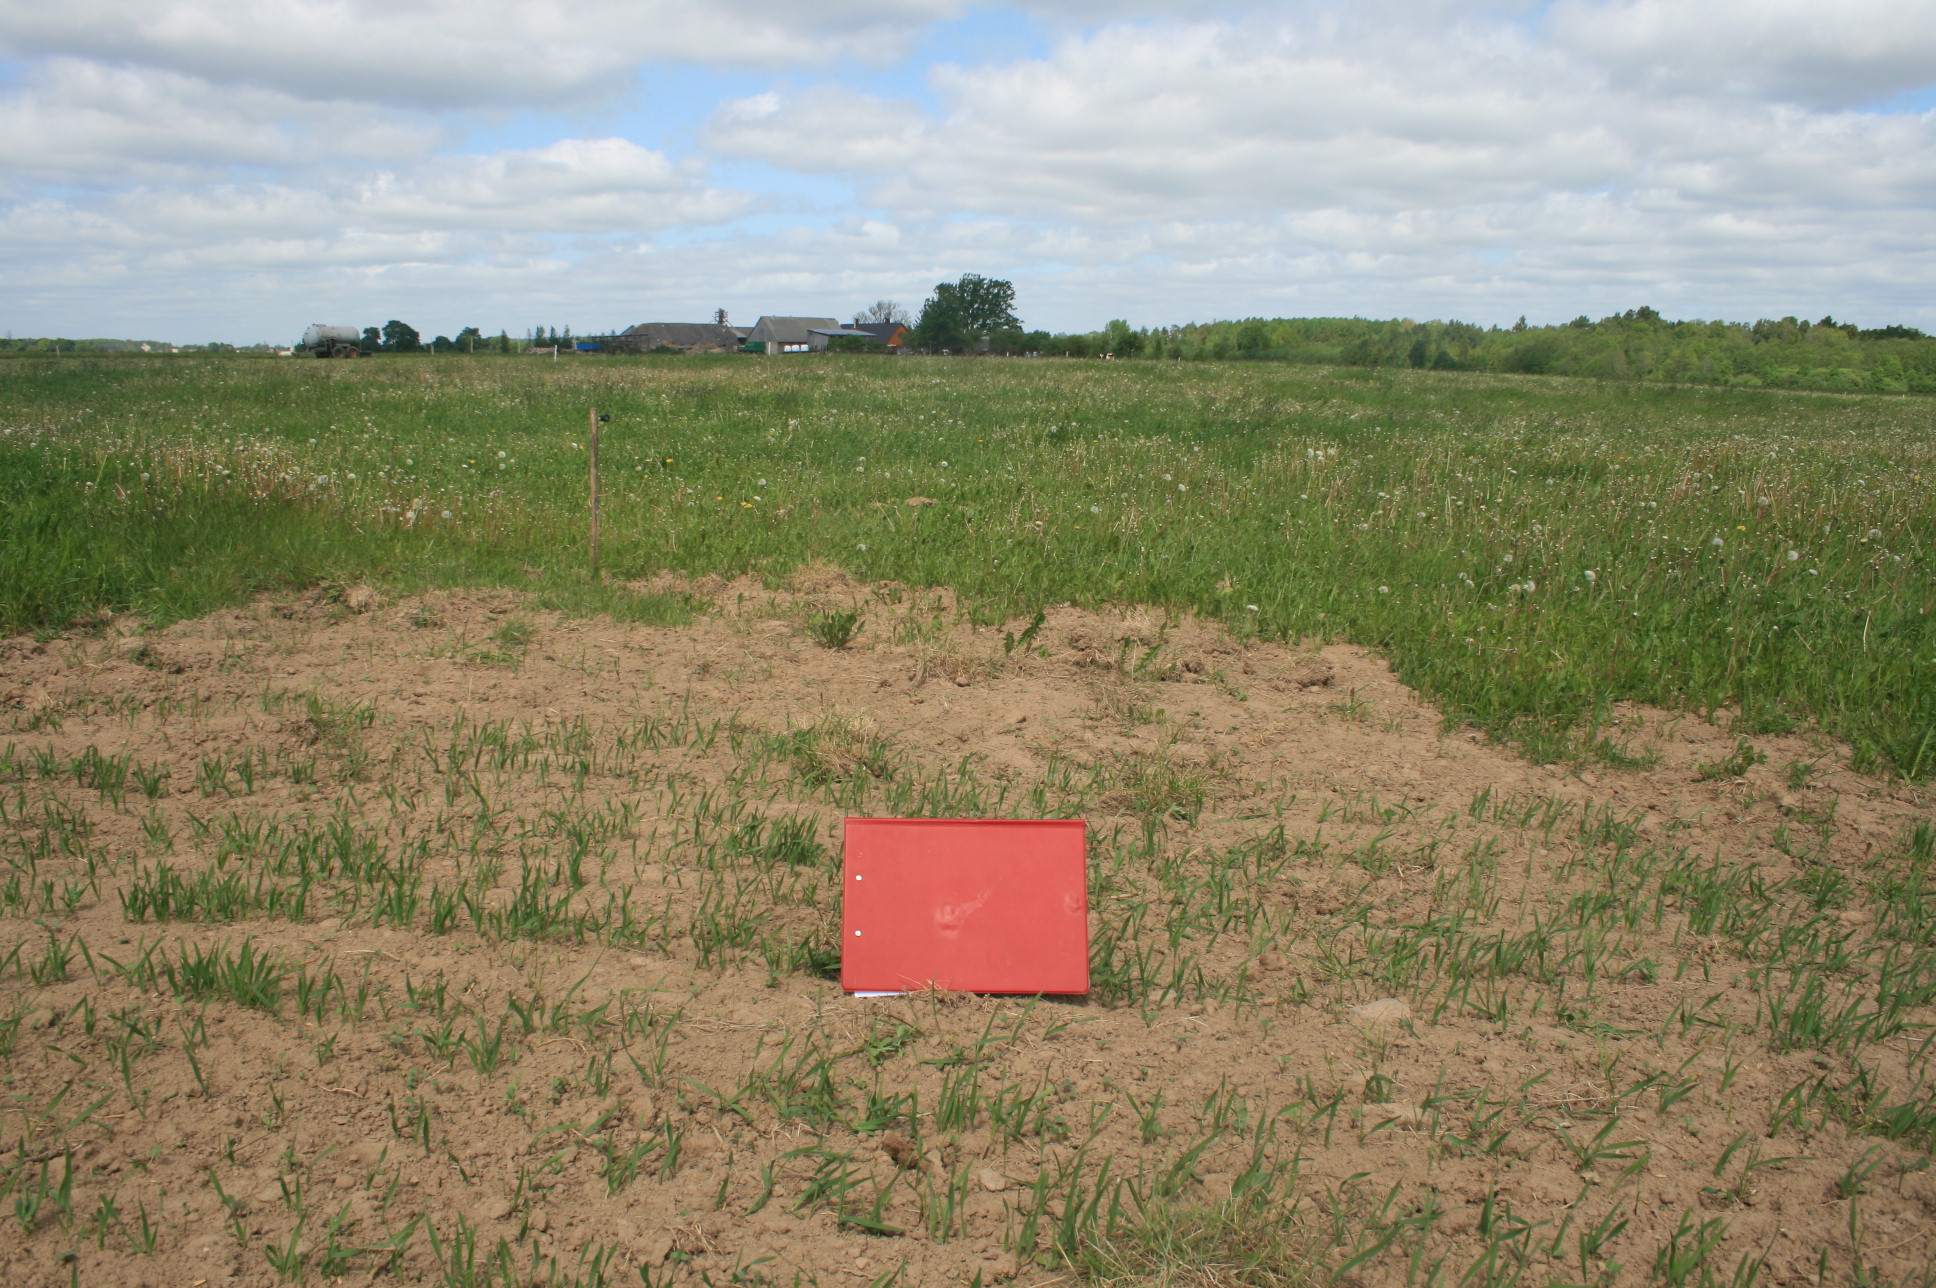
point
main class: Cropland
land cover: Other leguminous and mixtures for fodder
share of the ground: < 10 %
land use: Agriculture (excluding fallow land and kitchen gardens)
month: June
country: LT
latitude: 56.1893
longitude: 22.3508
